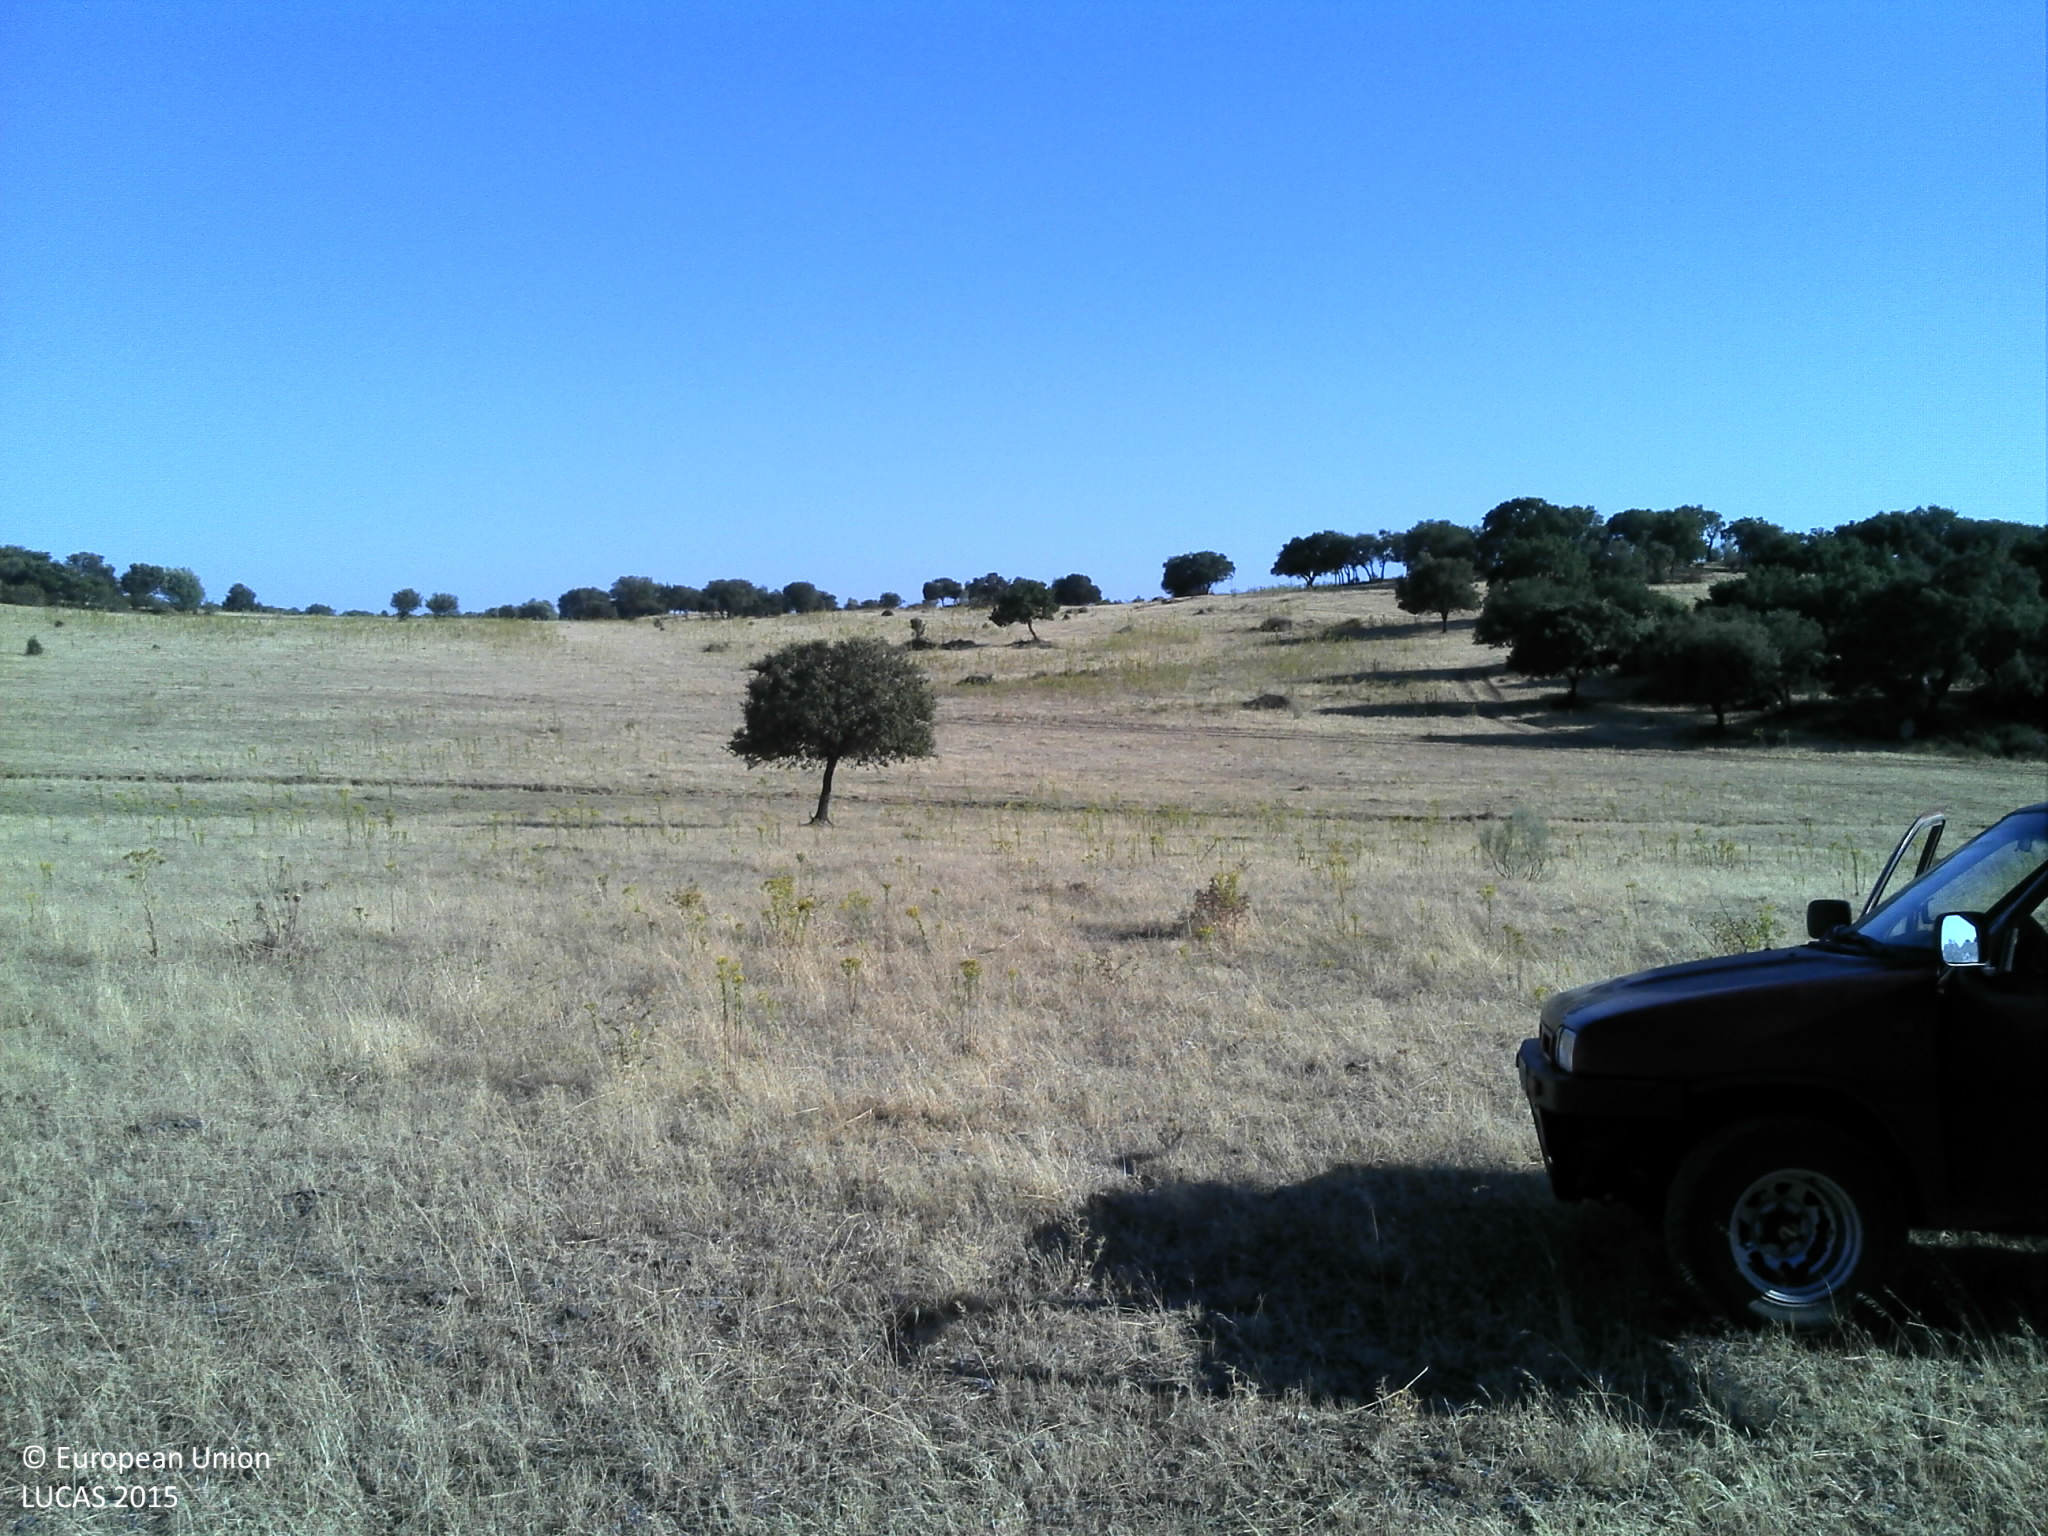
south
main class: Grassland
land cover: Grassland without tree/shrub cover
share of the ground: 25 - 50 %
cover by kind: unconsolidated bare surface 75 %, herbaceous plants 25 %
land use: Agriculture (excluding fallow land and kitchen gardens)
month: July
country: PT
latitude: 38.9716
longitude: -7.5241
